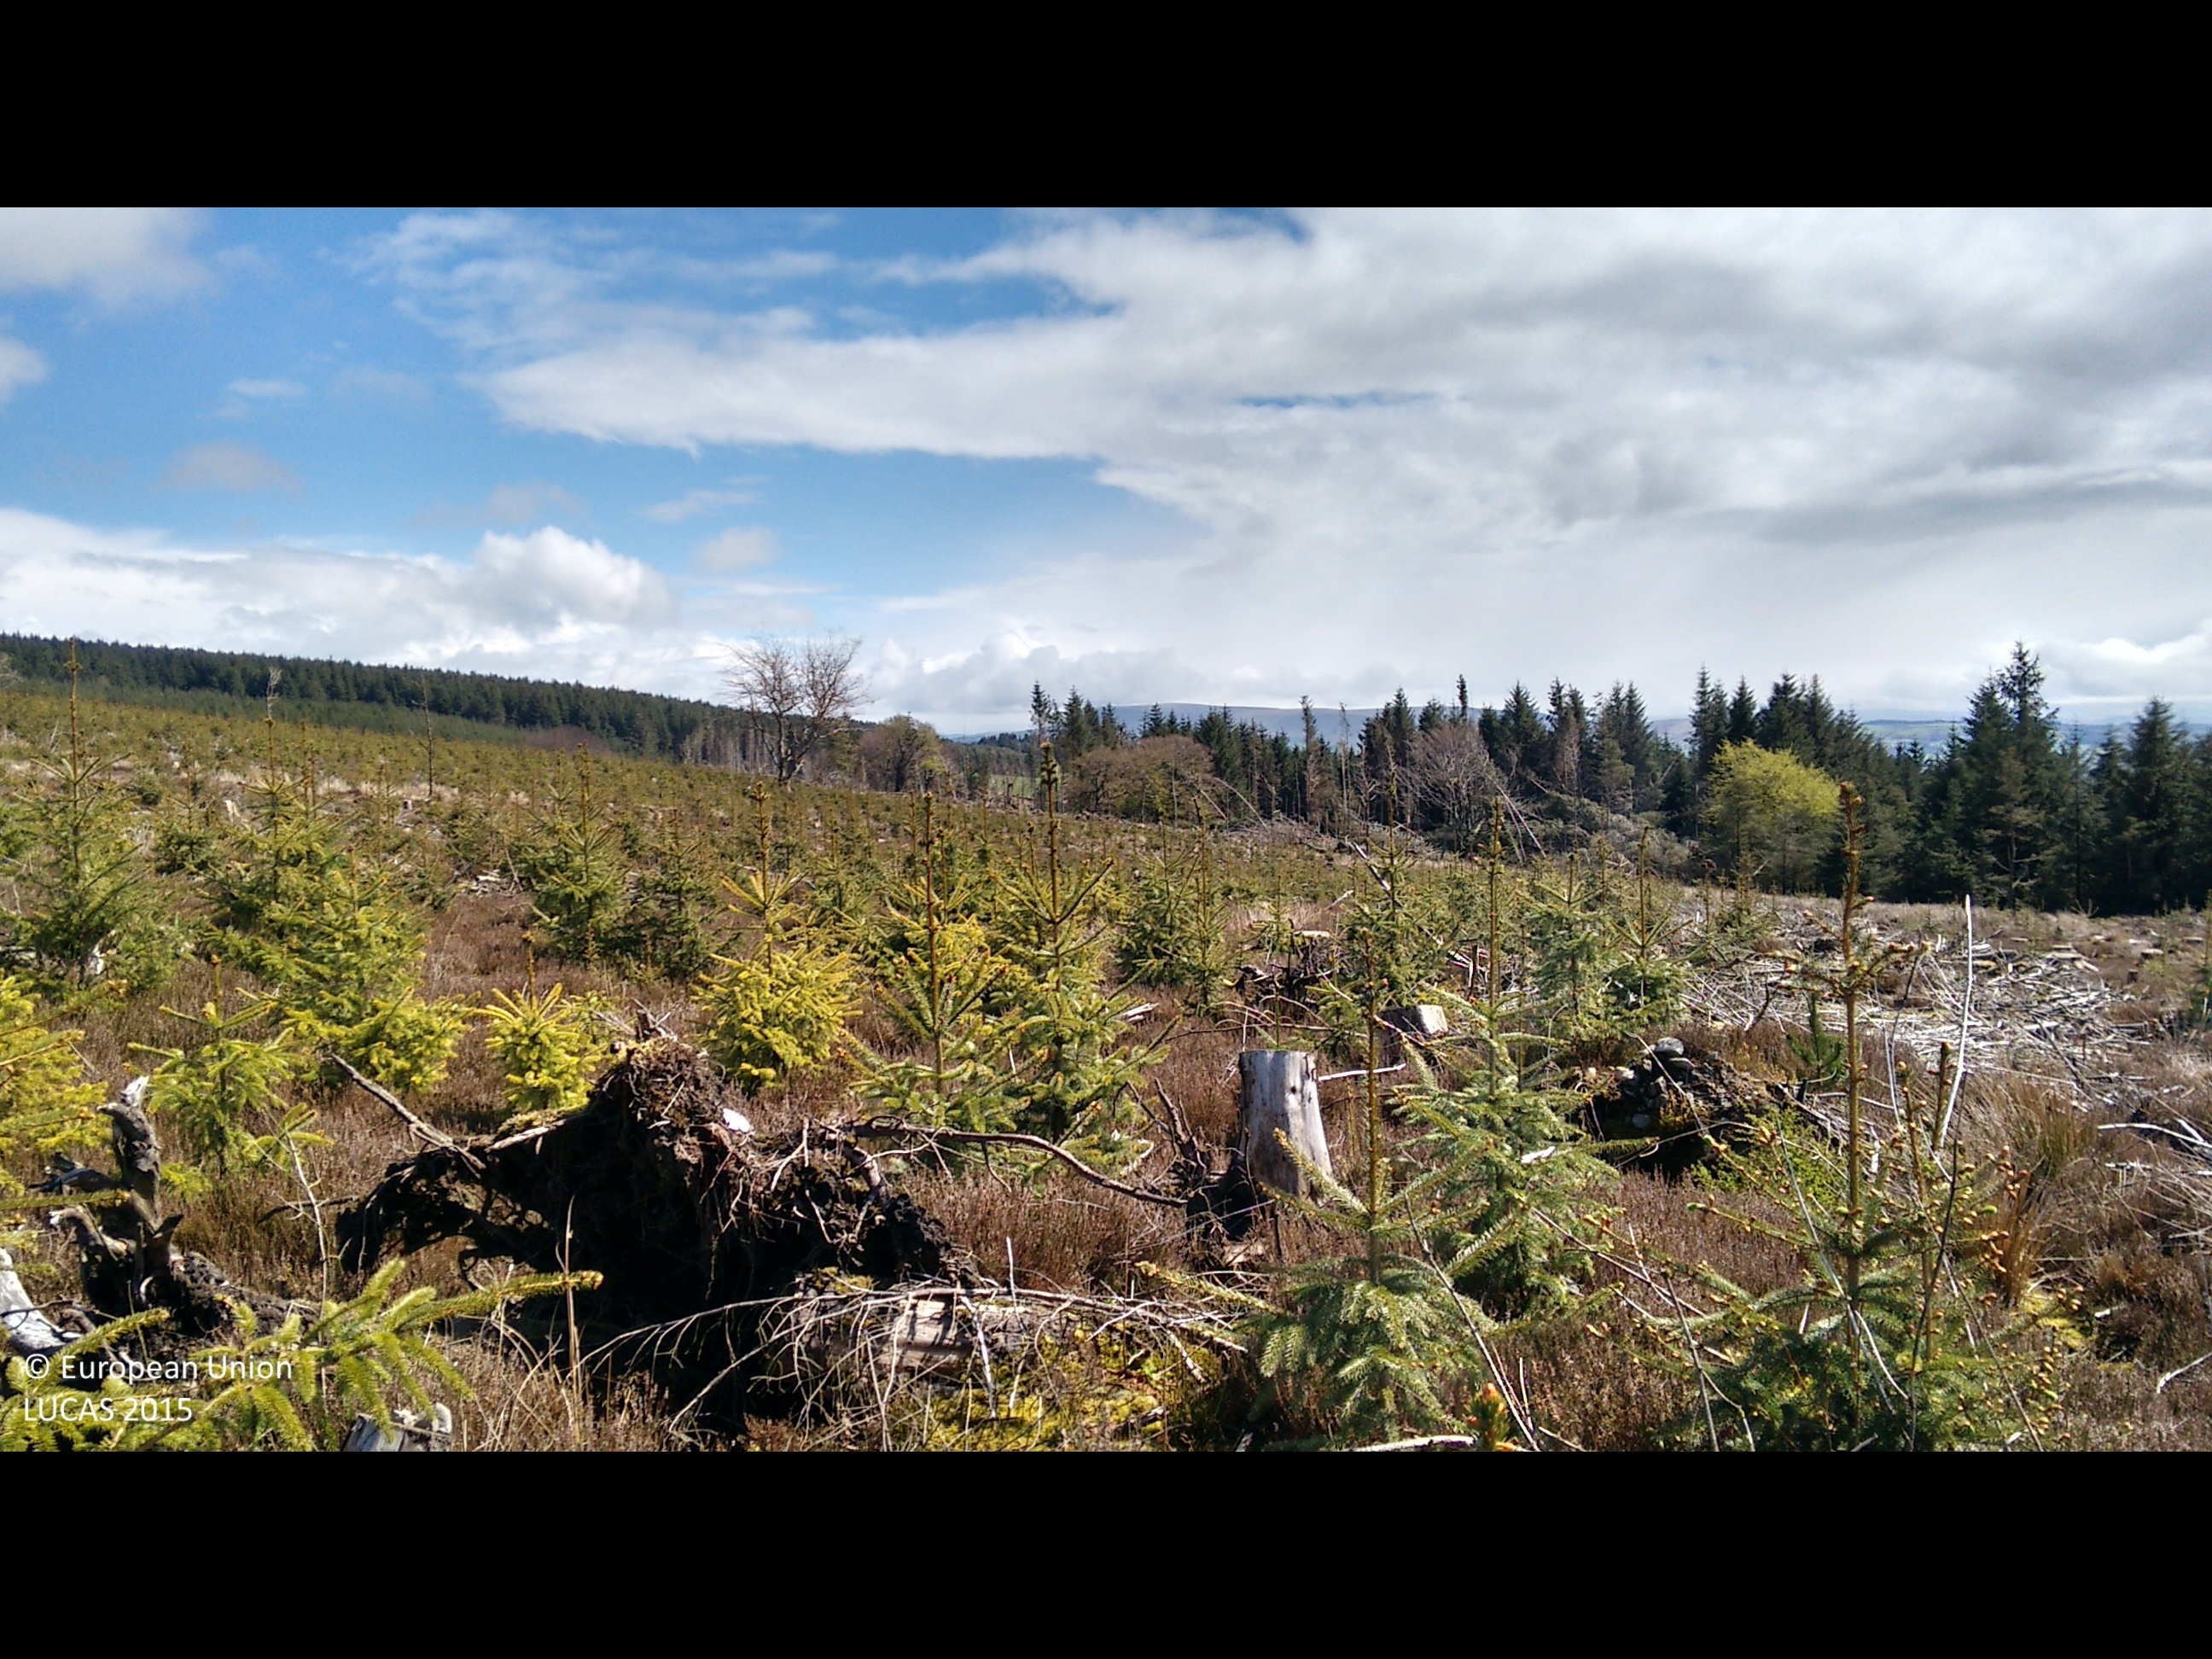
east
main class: Woodland
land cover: Spruce dominated coniferous woodland
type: exotic forest
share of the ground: 25 - 50 %
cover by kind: coniferous forest trees 50 %, herbaceous plants 35 %, shrubs 15 %
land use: Forestry
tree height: < 5 m
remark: Clear cut
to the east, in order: Spruce dominated coniferous woodland; Ditches and canals; Spruce dominated coniferous woodland
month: April
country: GB
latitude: 53.8597
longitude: -2.5178
